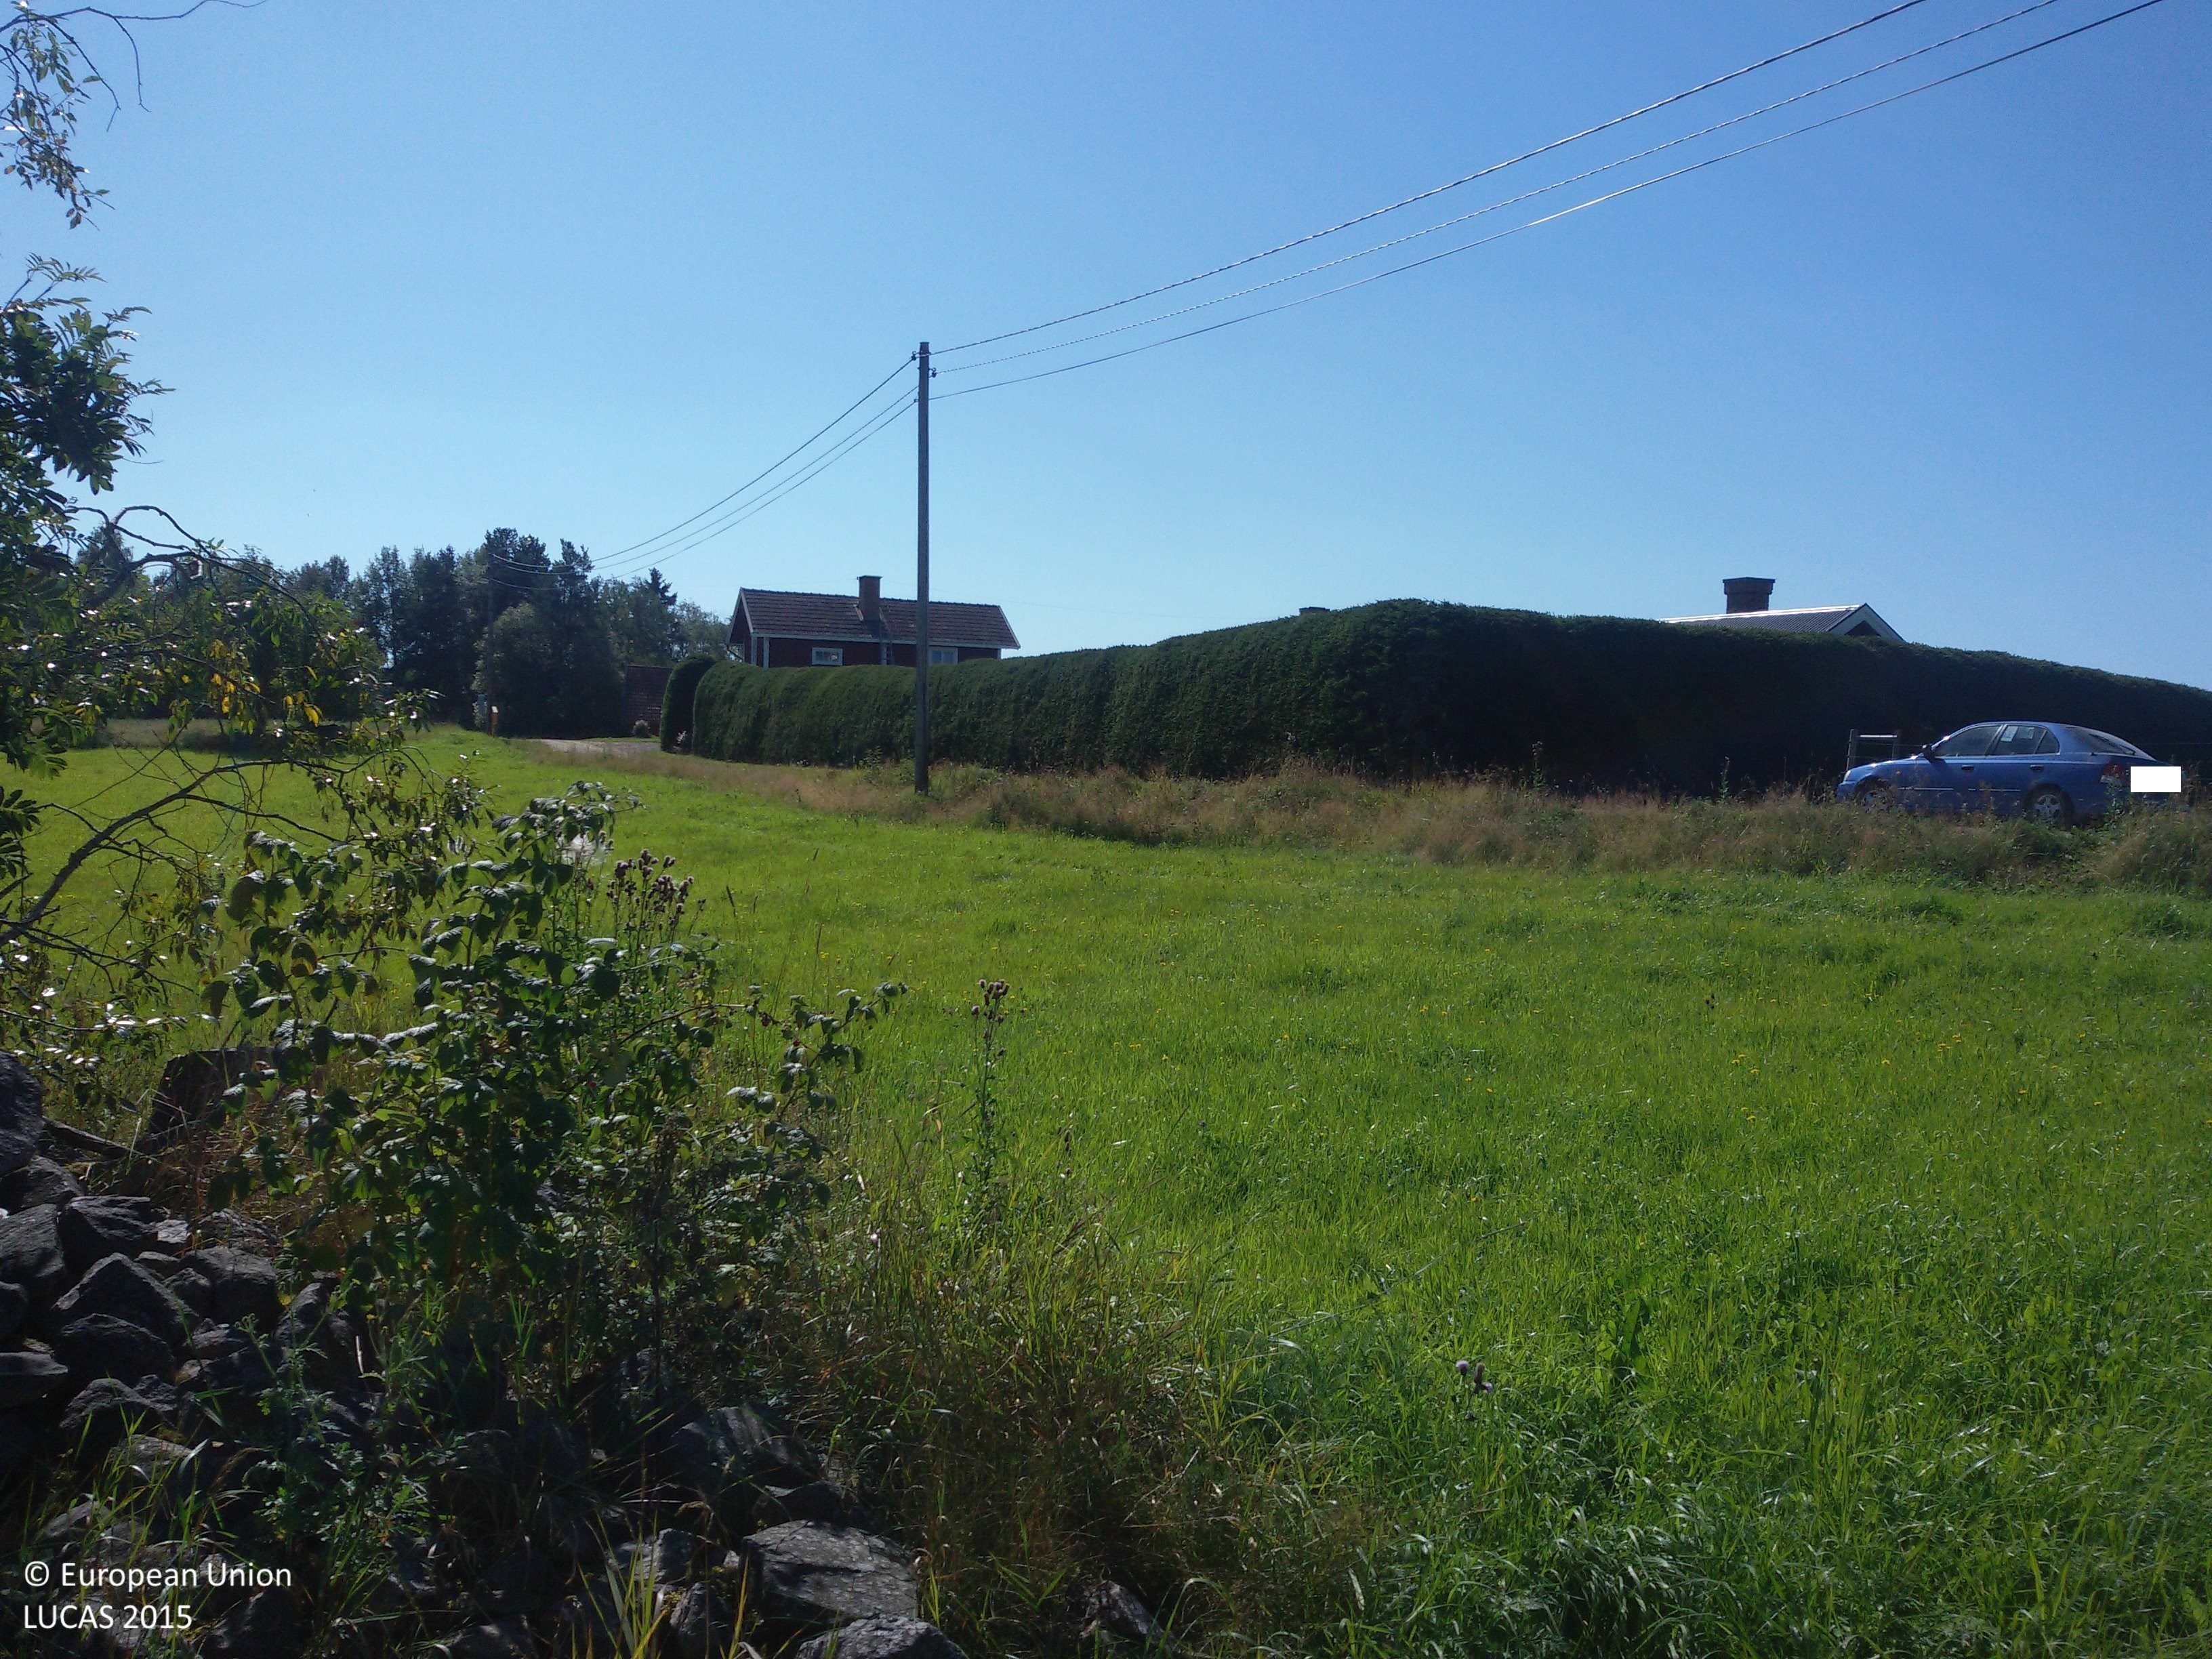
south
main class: Grassland
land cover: Grassland without tree/shrub cover
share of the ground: > 75 %
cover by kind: herbaceous plants 100 %
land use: Agriculture (excluding fallow land and kitchen gardens)
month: August
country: SE
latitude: 60.6370
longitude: 15.8561
